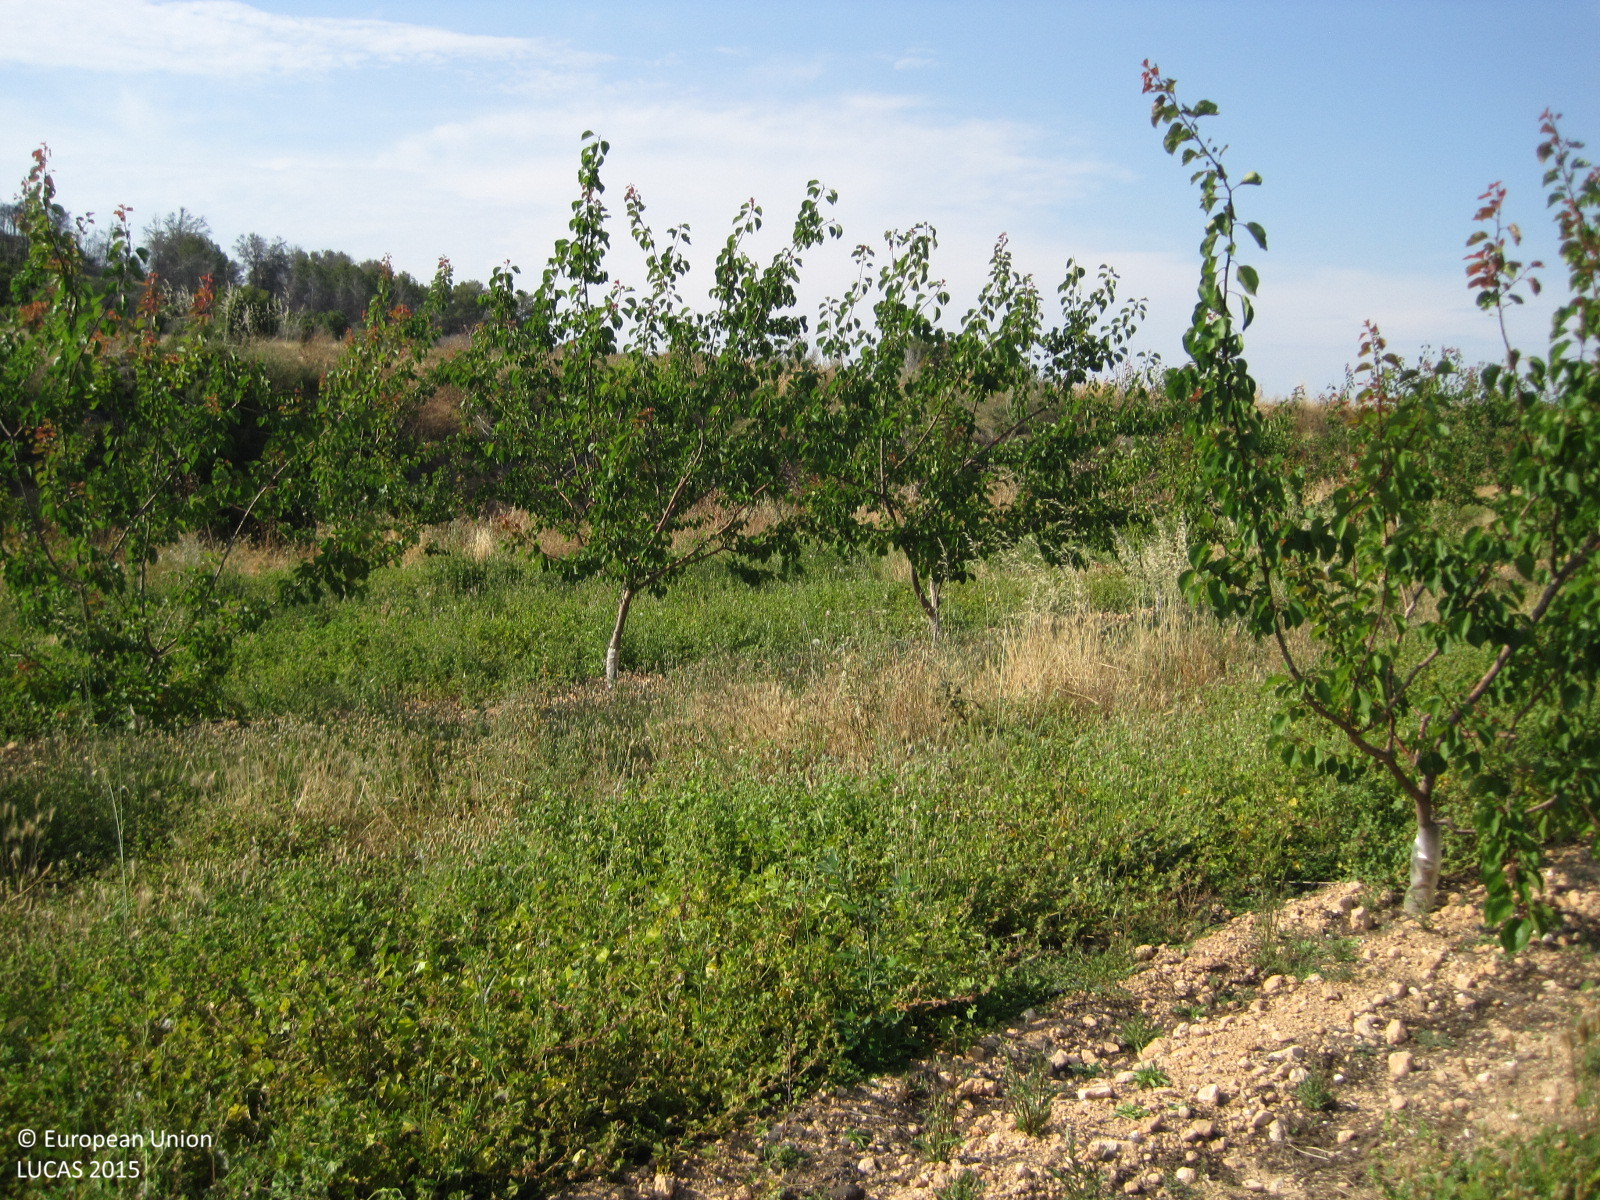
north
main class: Cropland
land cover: Other fruit trees and berries
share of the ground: 10 - 25 %
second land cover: Spontaneously vegetated surfaces
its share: > 75 %
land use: Agriculture (excluding fallow land and kitchen gardens)
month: June
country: ES
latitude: 39.3025
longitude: -0.6537
